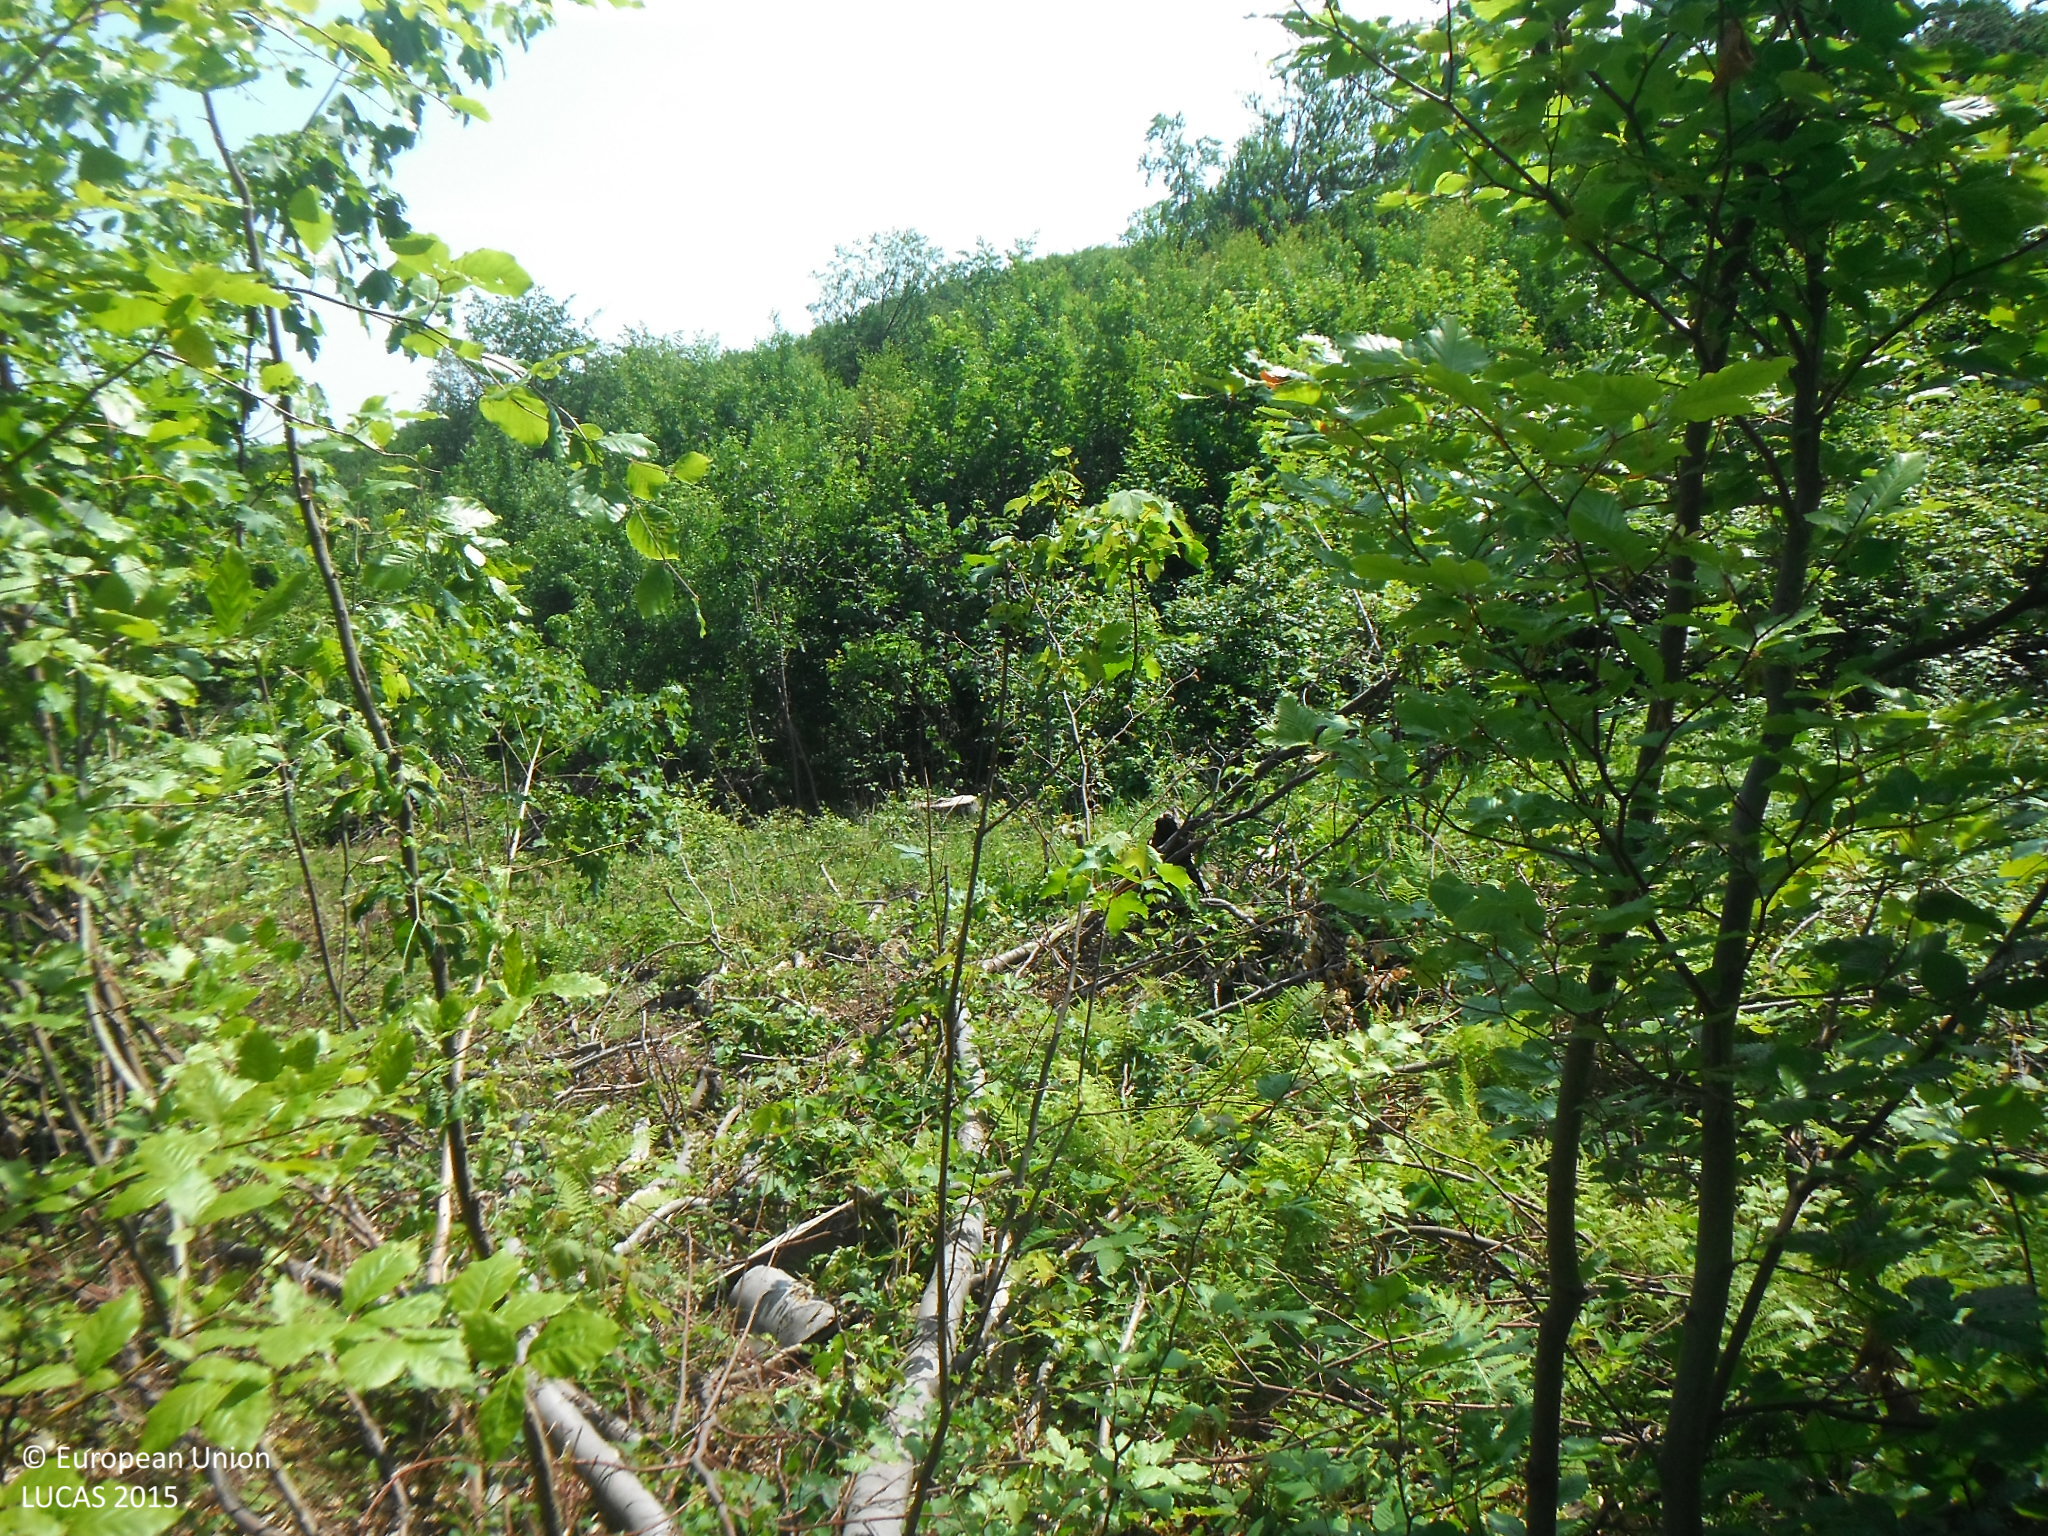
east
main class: Woodland
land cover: Broadleaved woodland
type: beech forest
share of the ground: > 75 %
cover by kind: broadleaved forest trees 100 %
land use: Forestry
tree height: > 5 m
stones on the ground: > 50 %
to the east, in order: Broadleaved woodland; Shrubland without tree cover; Tracks; Shrubland without tree cover; Broadleaved woodland; Ditches and canals; Broadleaved woodland
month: June
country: SK
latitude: 48.9839
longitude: 21.4853
